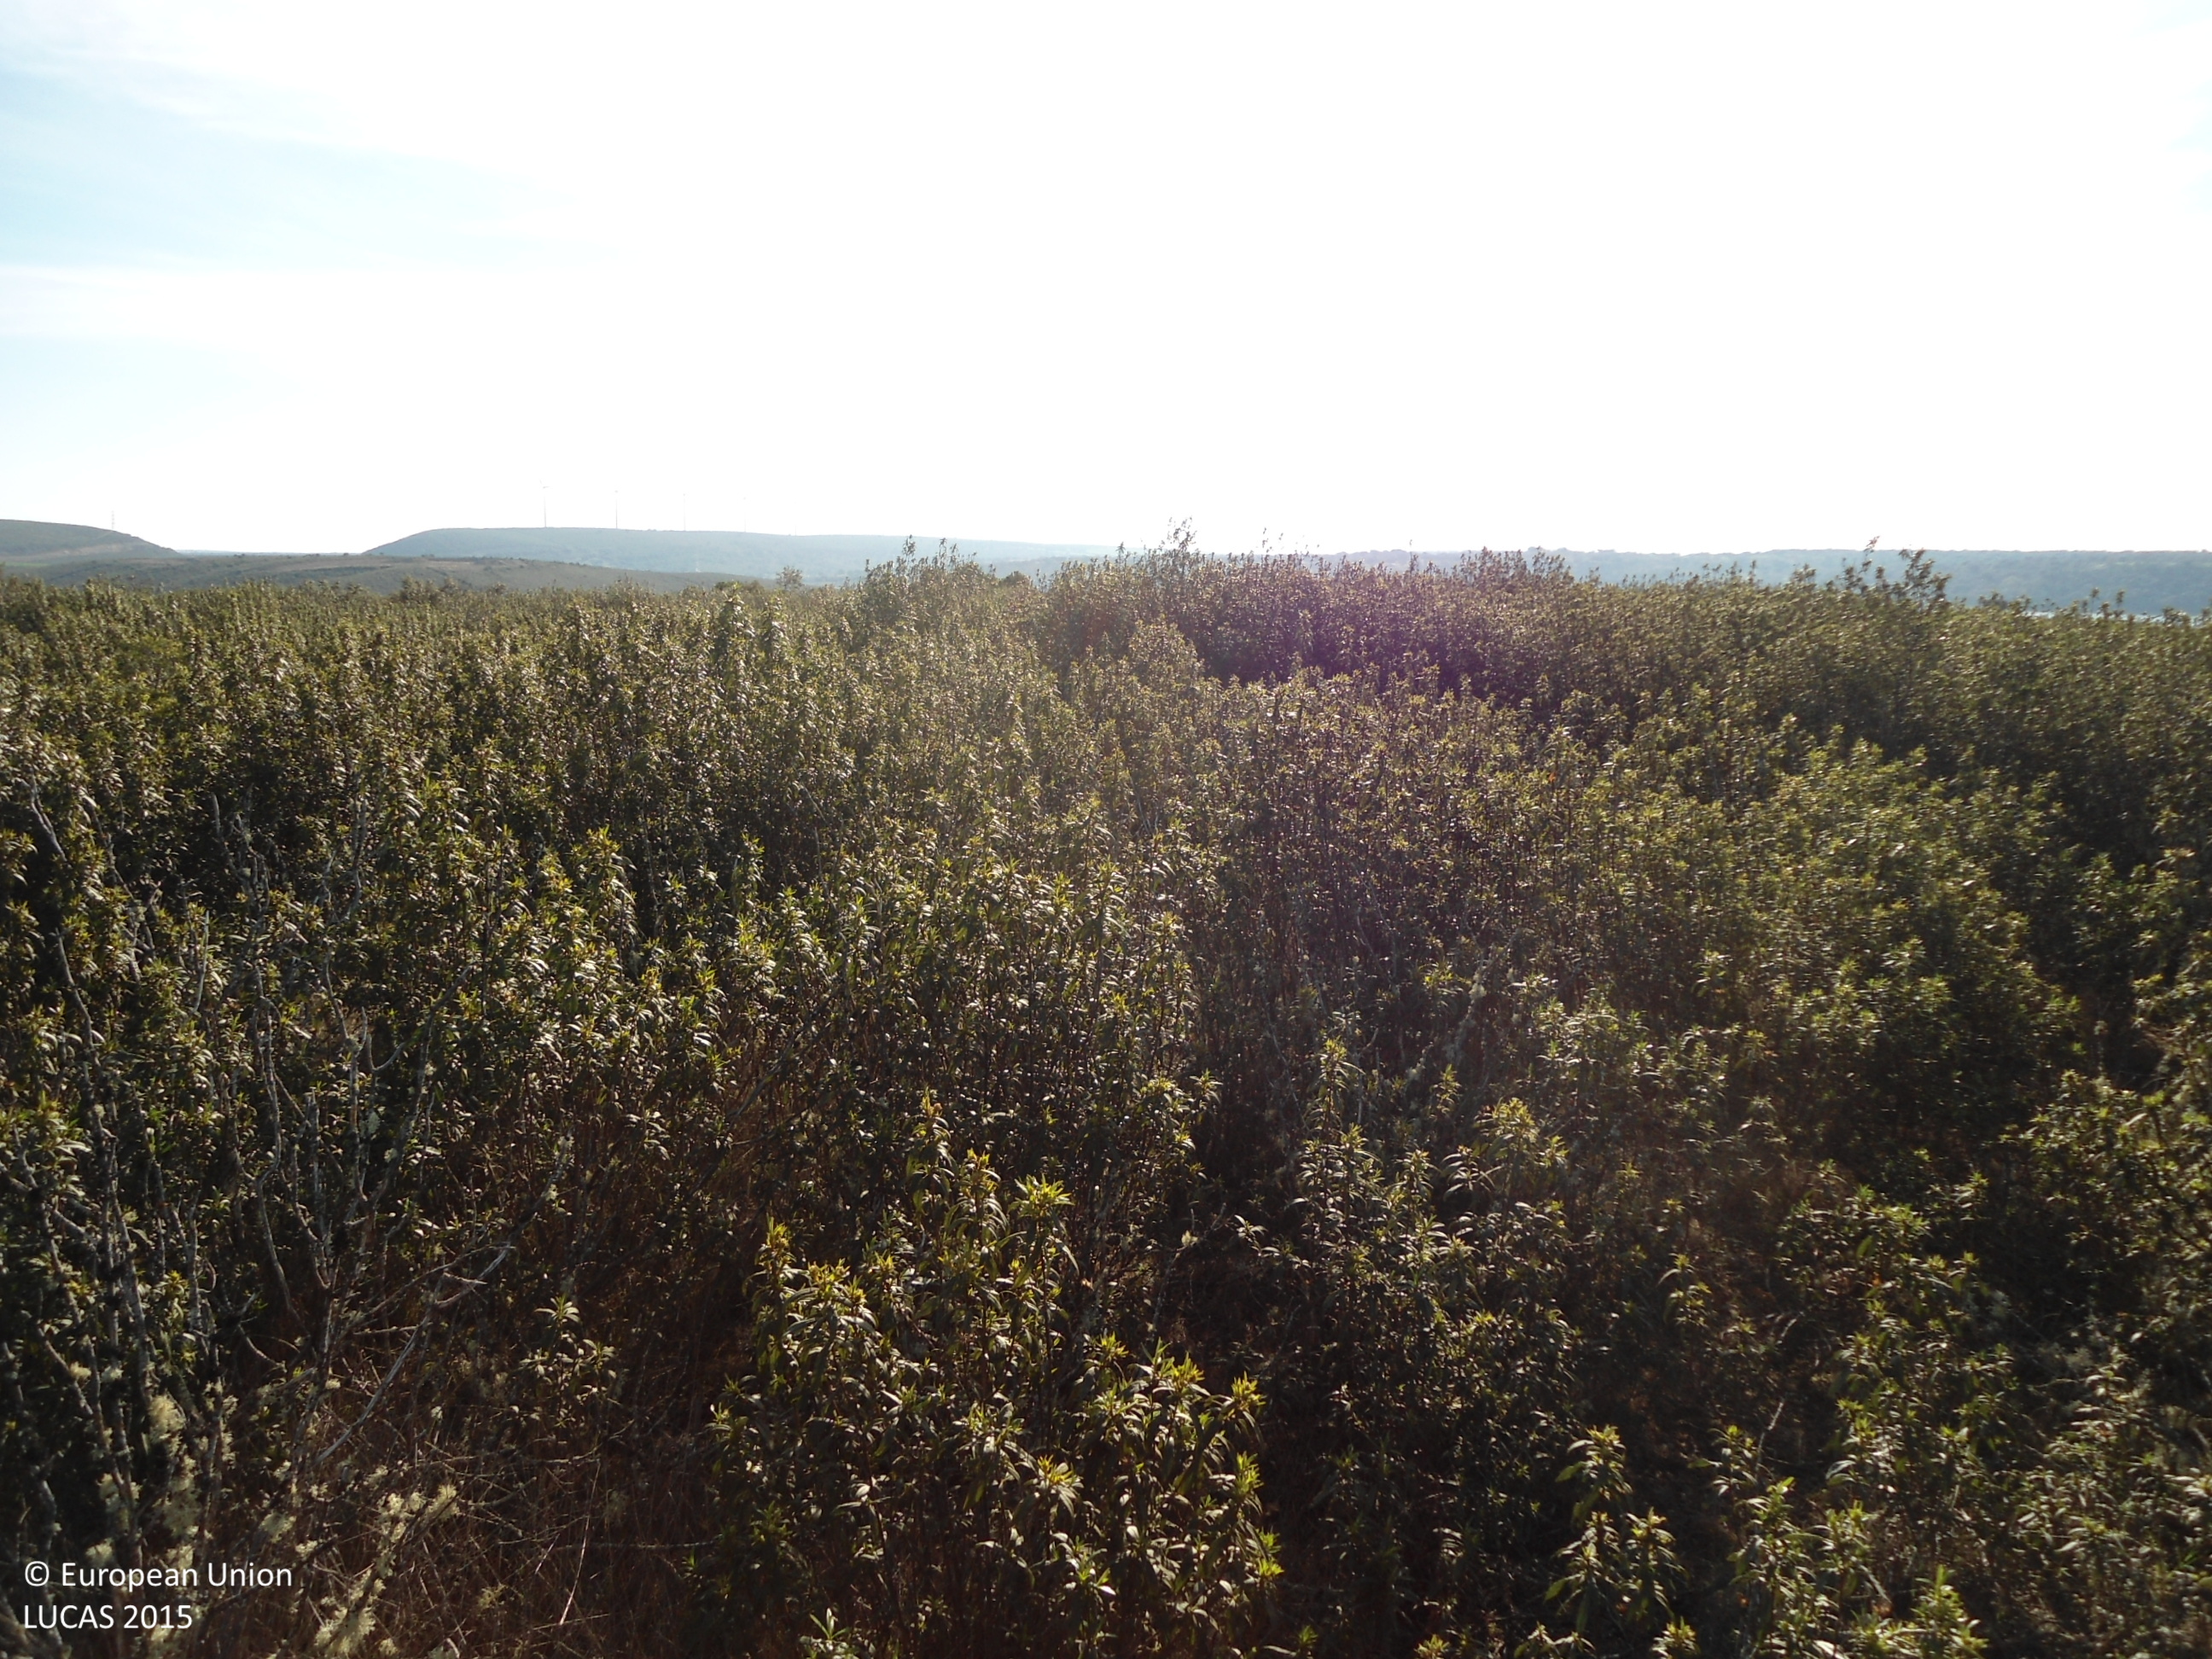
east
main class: Shrubland
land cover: Shrubland without tree cover
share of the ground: > 75 %
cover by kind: shrubs 100 %
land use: Semi-natural and natural areas not in use
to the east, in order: Shrubland without tree cover; Tracks; Shrubland without tree cover; Tracks; Pine dominated coniferous woodland
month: April
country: ES
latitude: 41.6415
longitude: -5.9276
